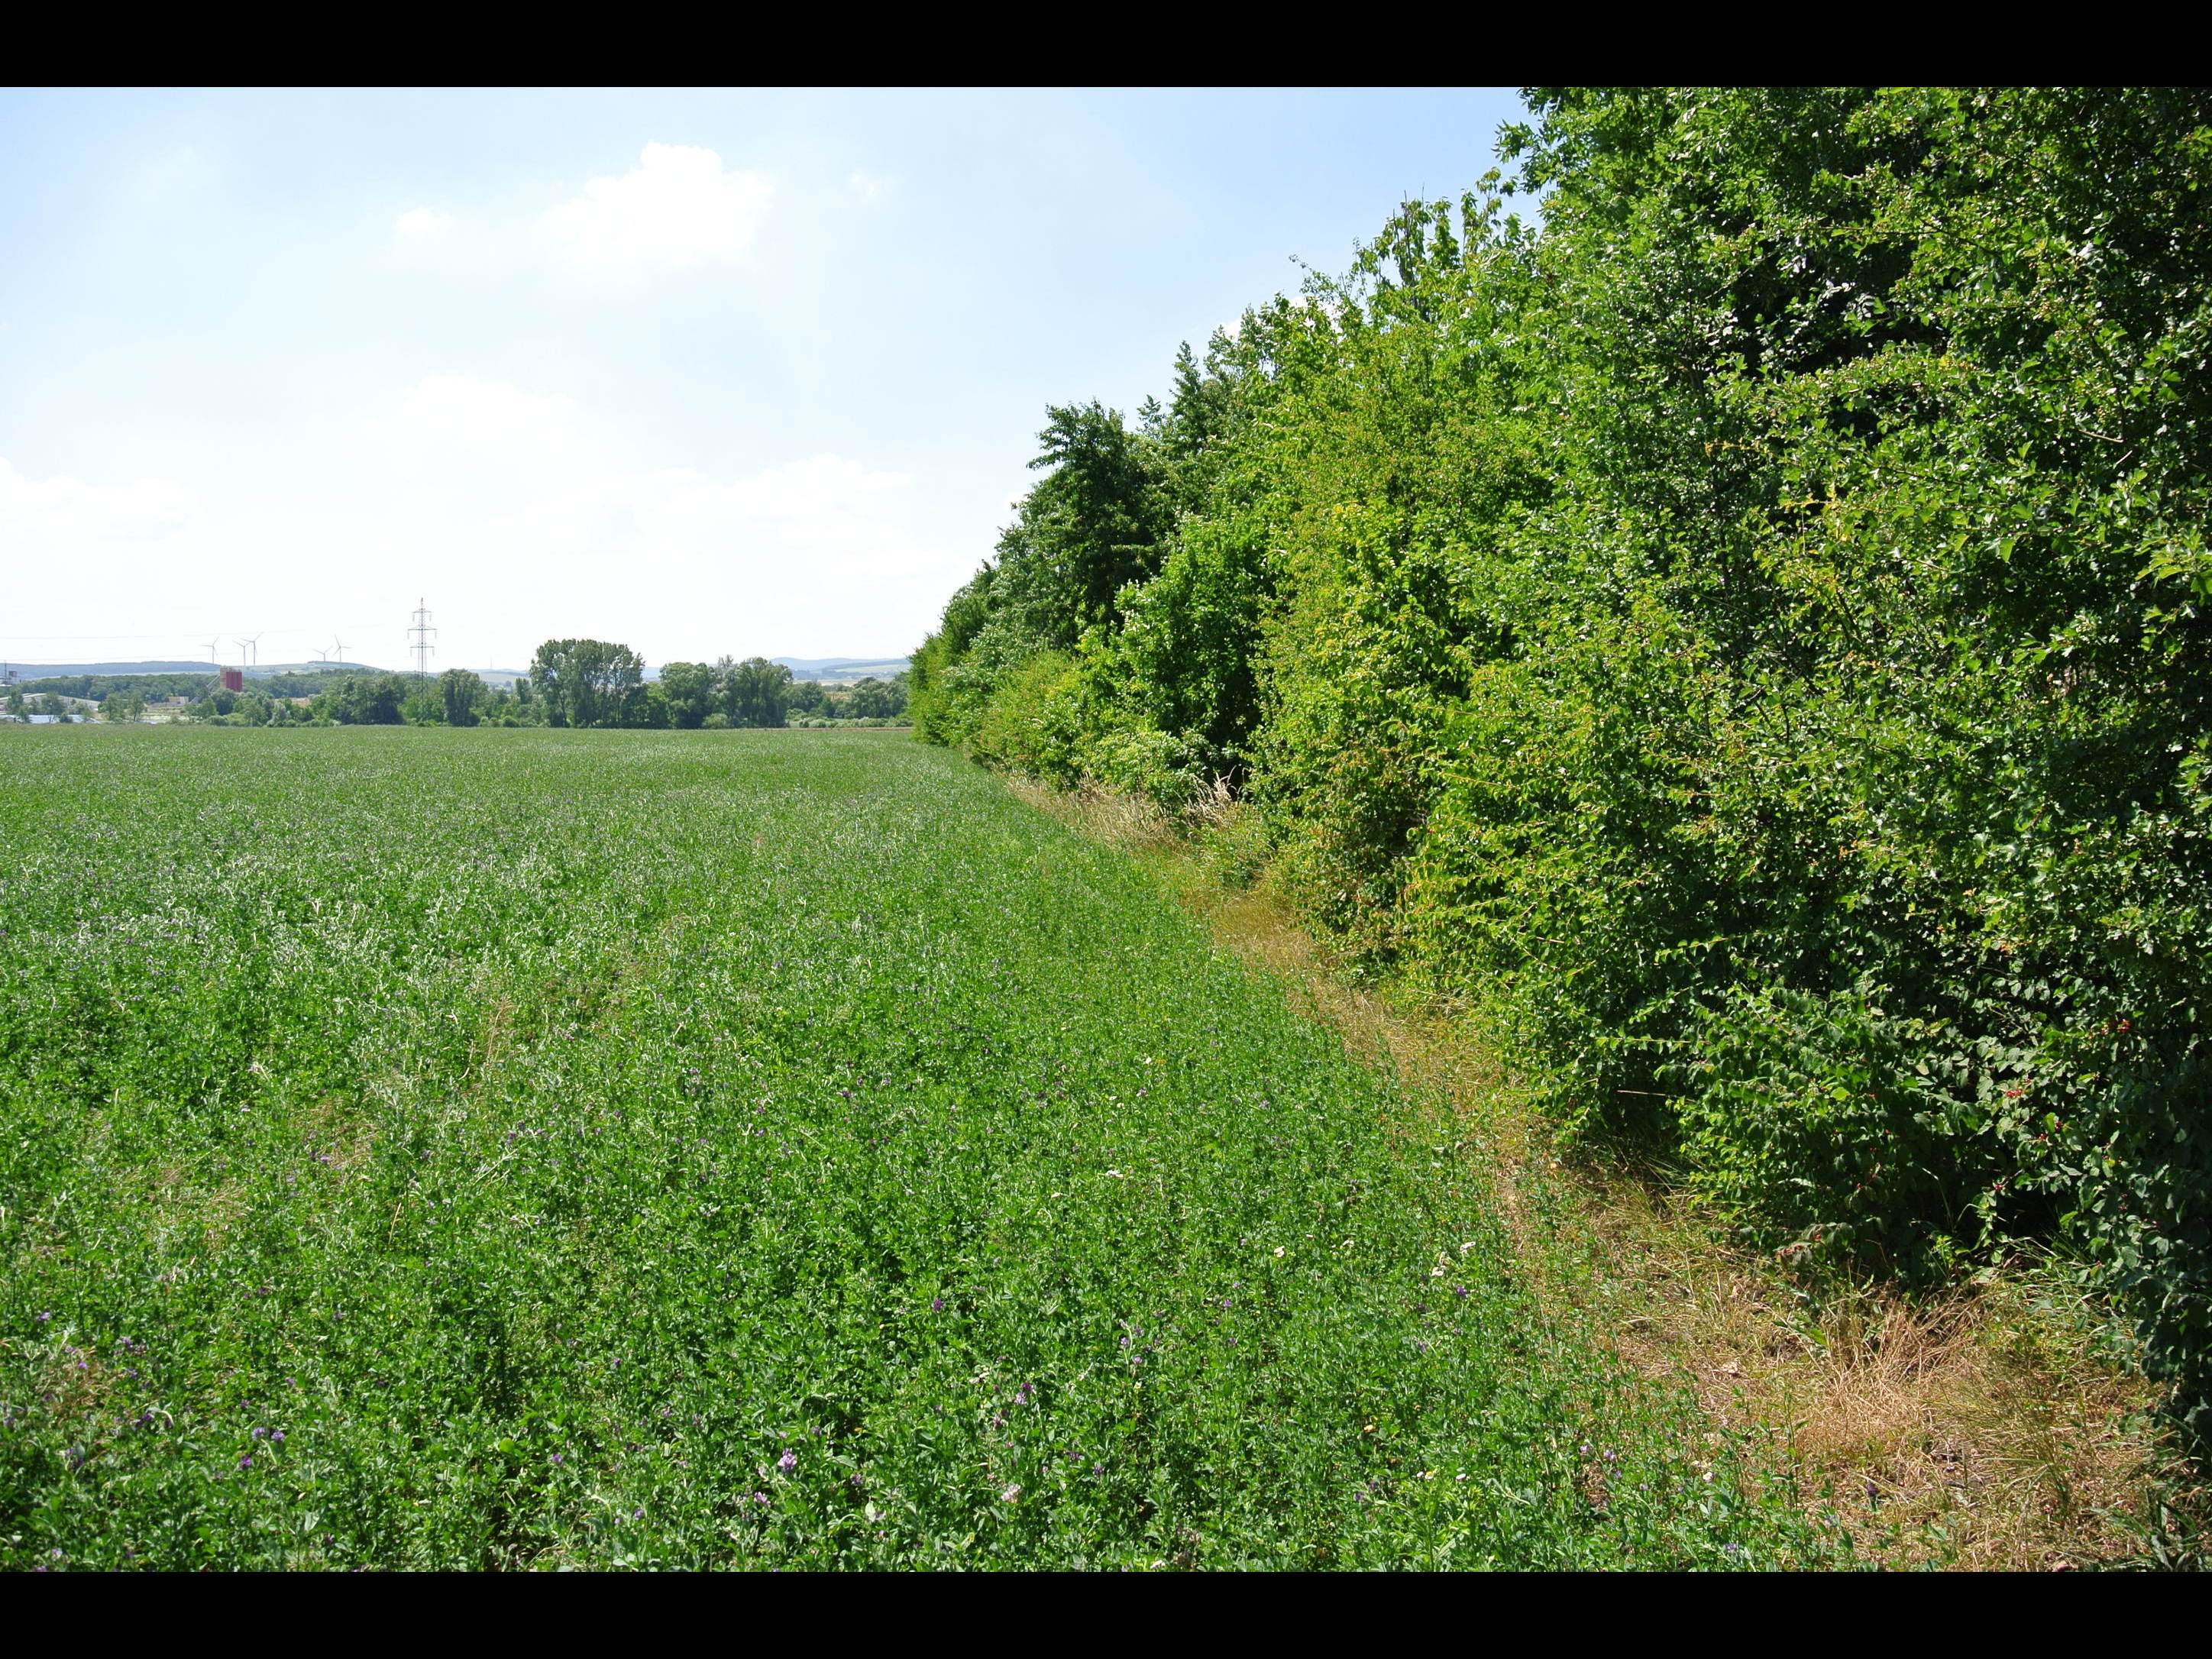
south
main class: Cropland
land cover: Lucerne
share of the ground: > 75 %
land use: Agriculture (excluding fallow land and kitchen gardens)
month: June
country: AT
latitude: 47.7982
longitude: 16.4796
